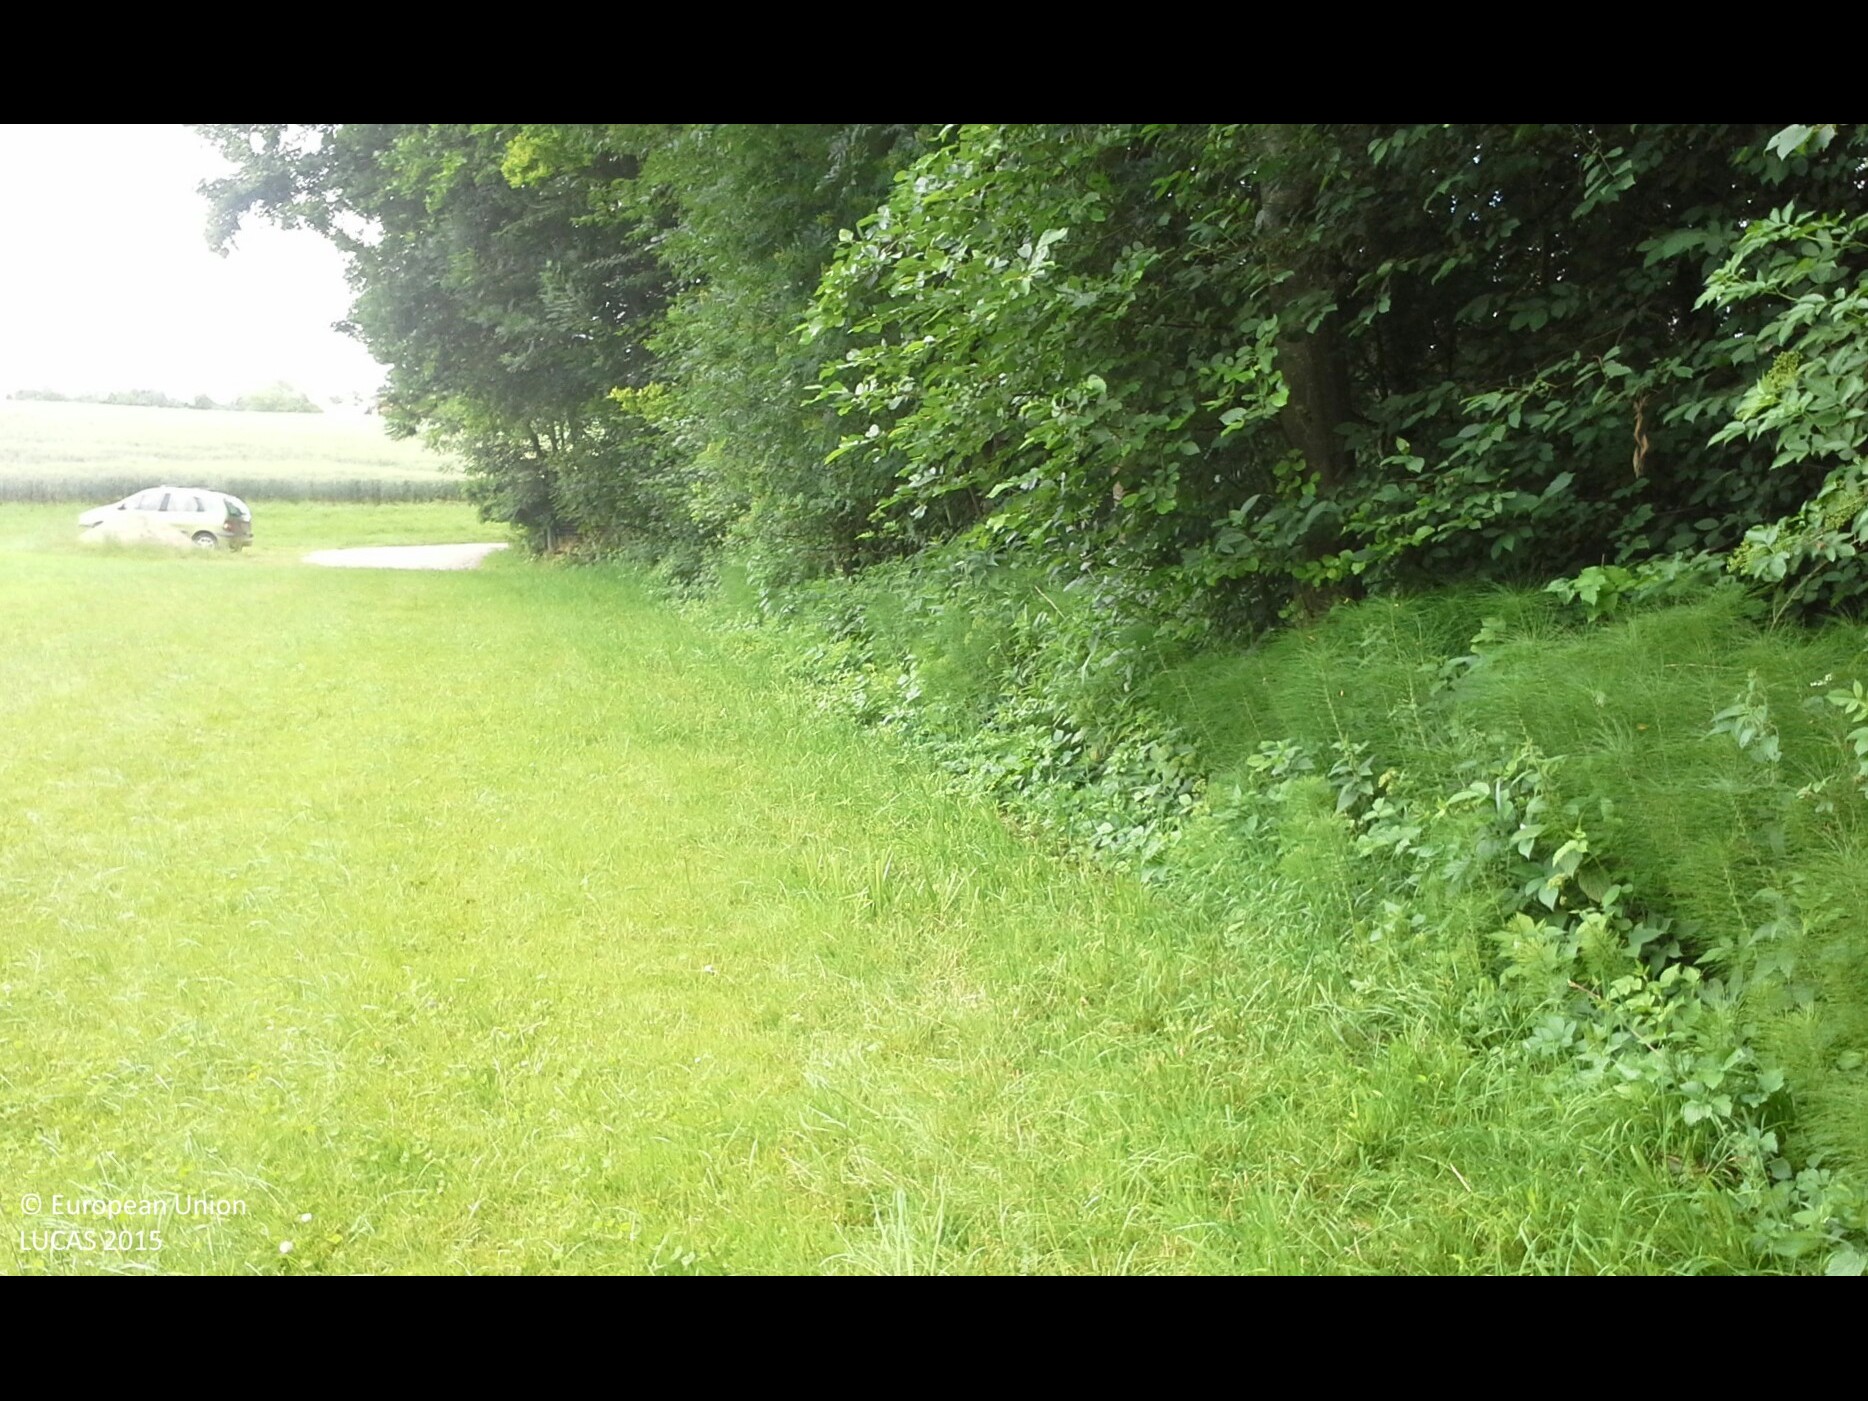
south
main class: Grassland
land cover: Grassland without tree/shrub cover
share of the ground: > 75 %
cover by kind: herbaceous plants 100 %
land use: Agriculture (excluding fallow land and kitchen gardens)
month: June
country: AT
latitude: 48.0733
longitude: 14.6039
